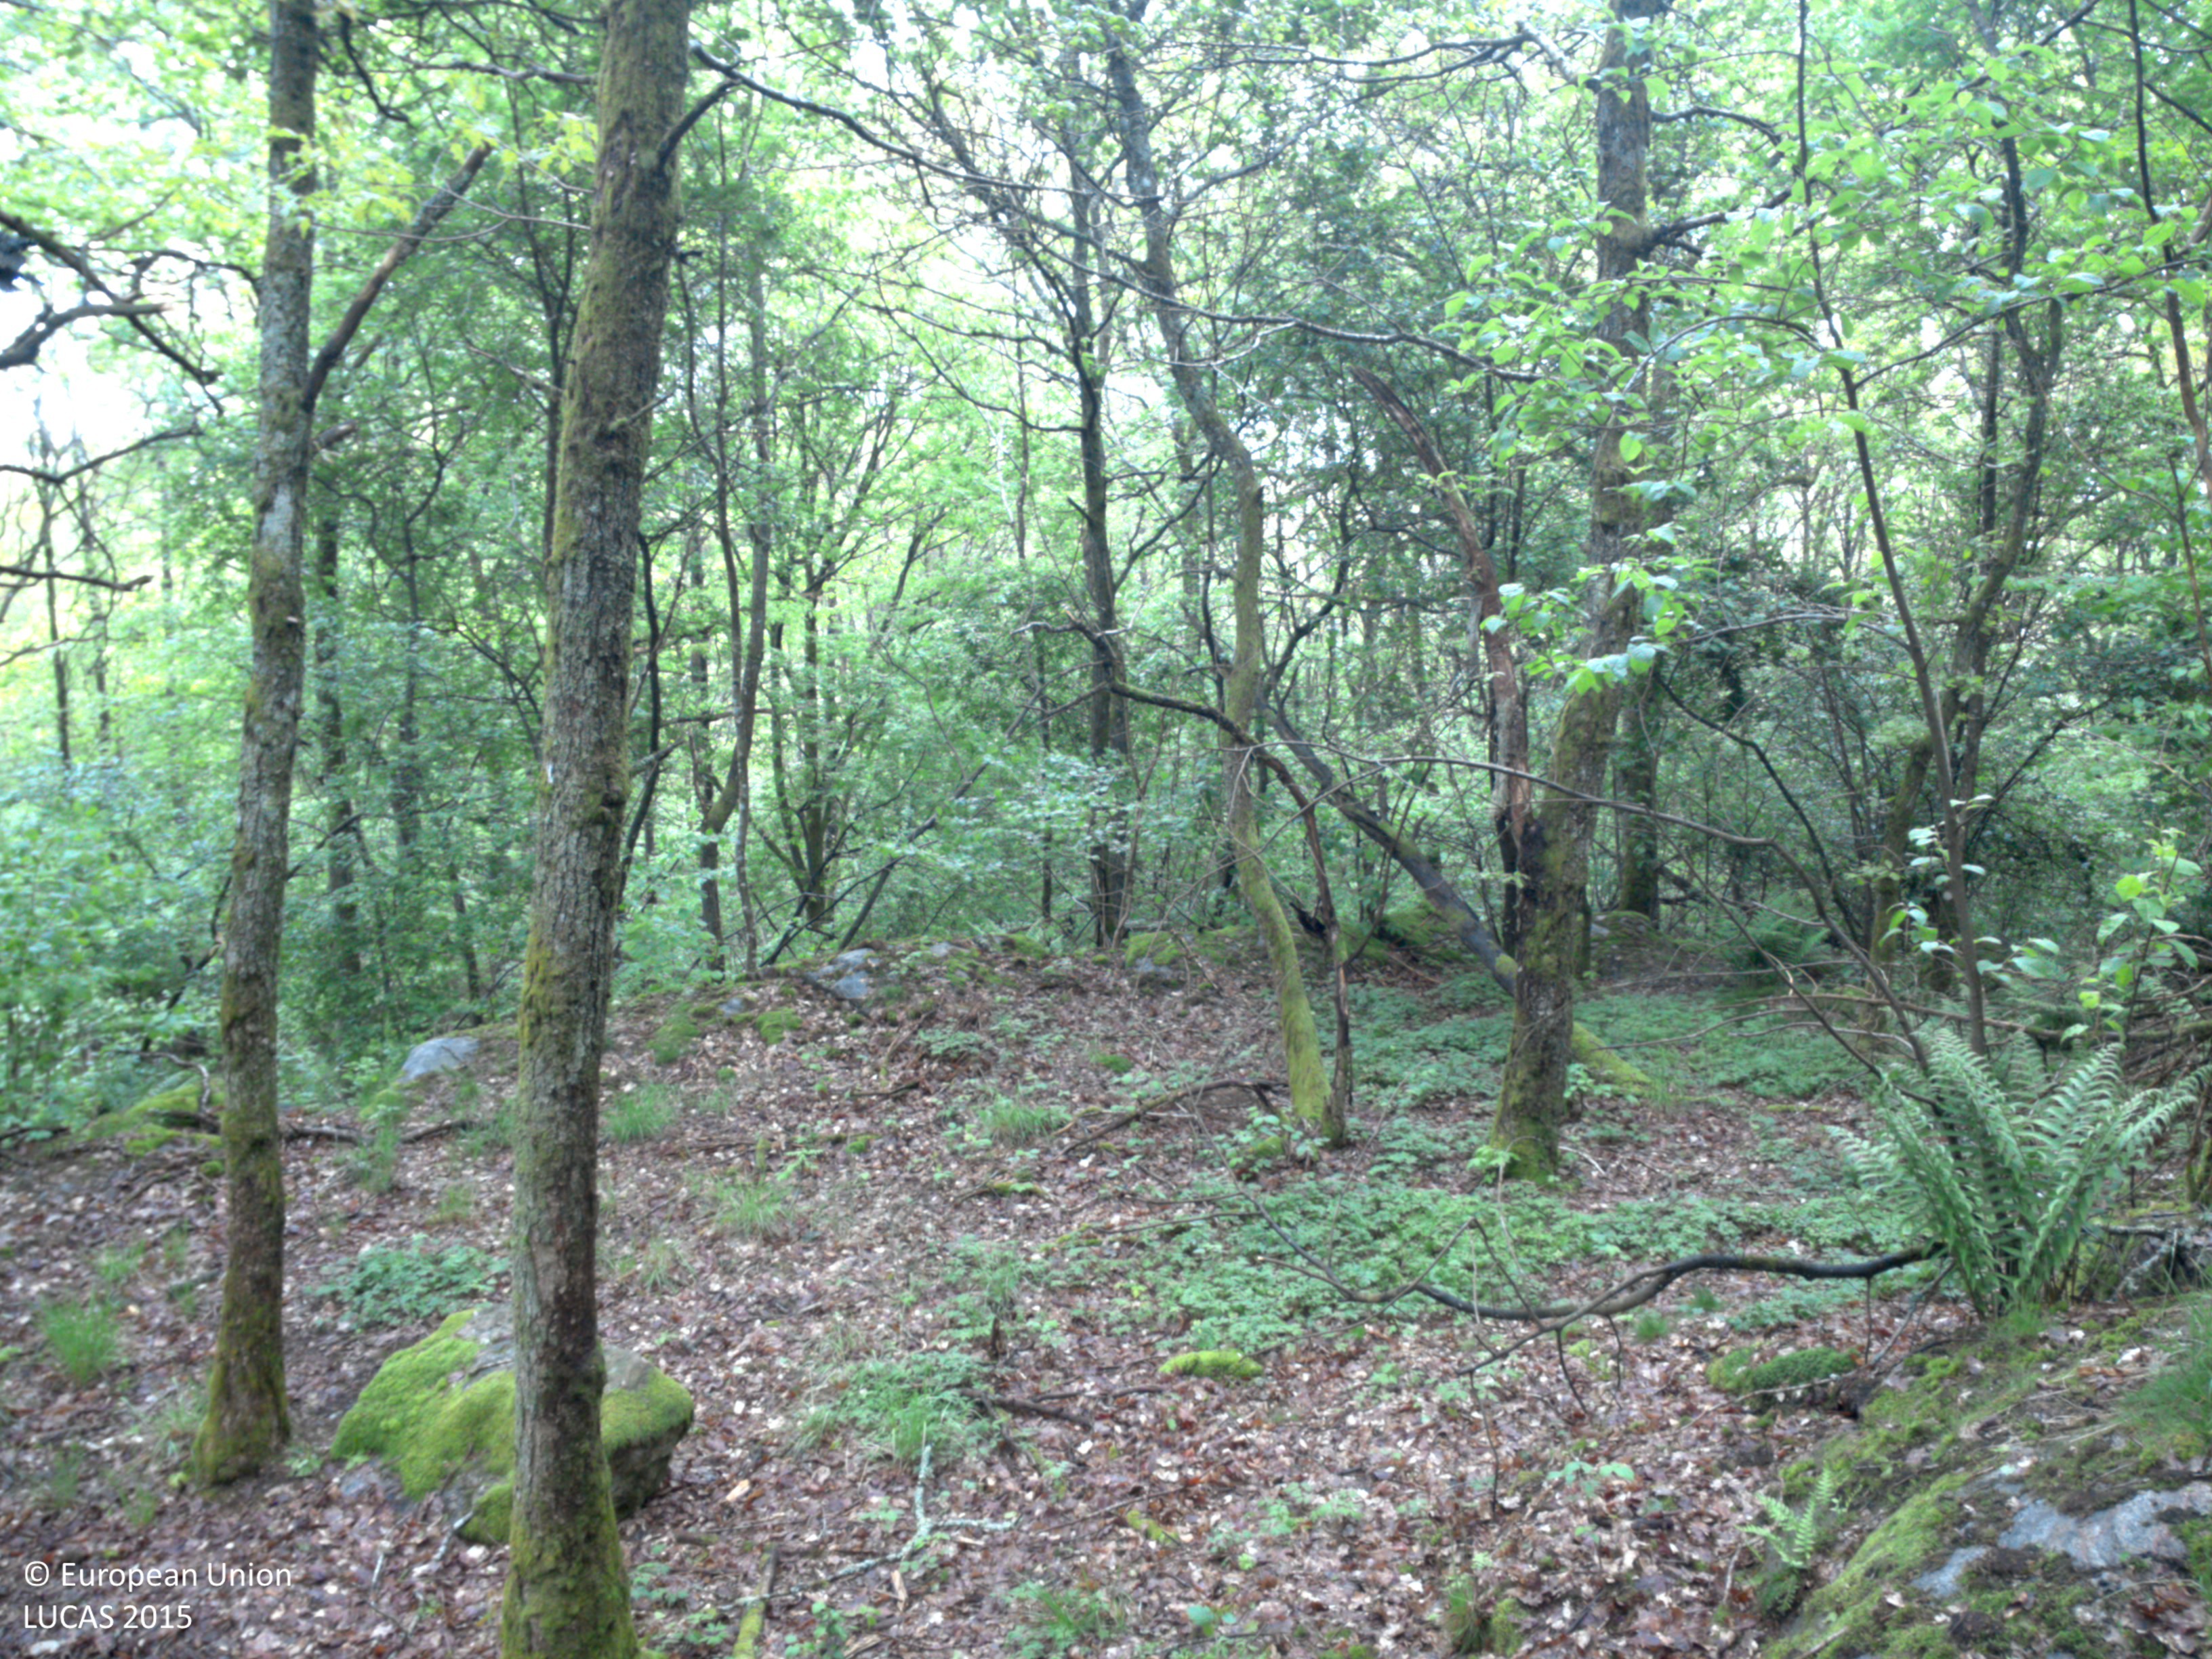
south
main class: Woodland
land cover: Broadleaved woodland
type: mesophytic deciduous forest
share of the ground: 50 - 75 %
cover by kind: broadleaved forest trees 70 %, herbaceous plants 20 %, shrubs 10 %
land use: Amenities, museums, leisure
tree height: > 5 m
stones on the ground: 10 - 25 %
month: June
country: SE
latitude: 57.8812
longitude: 11.9695
